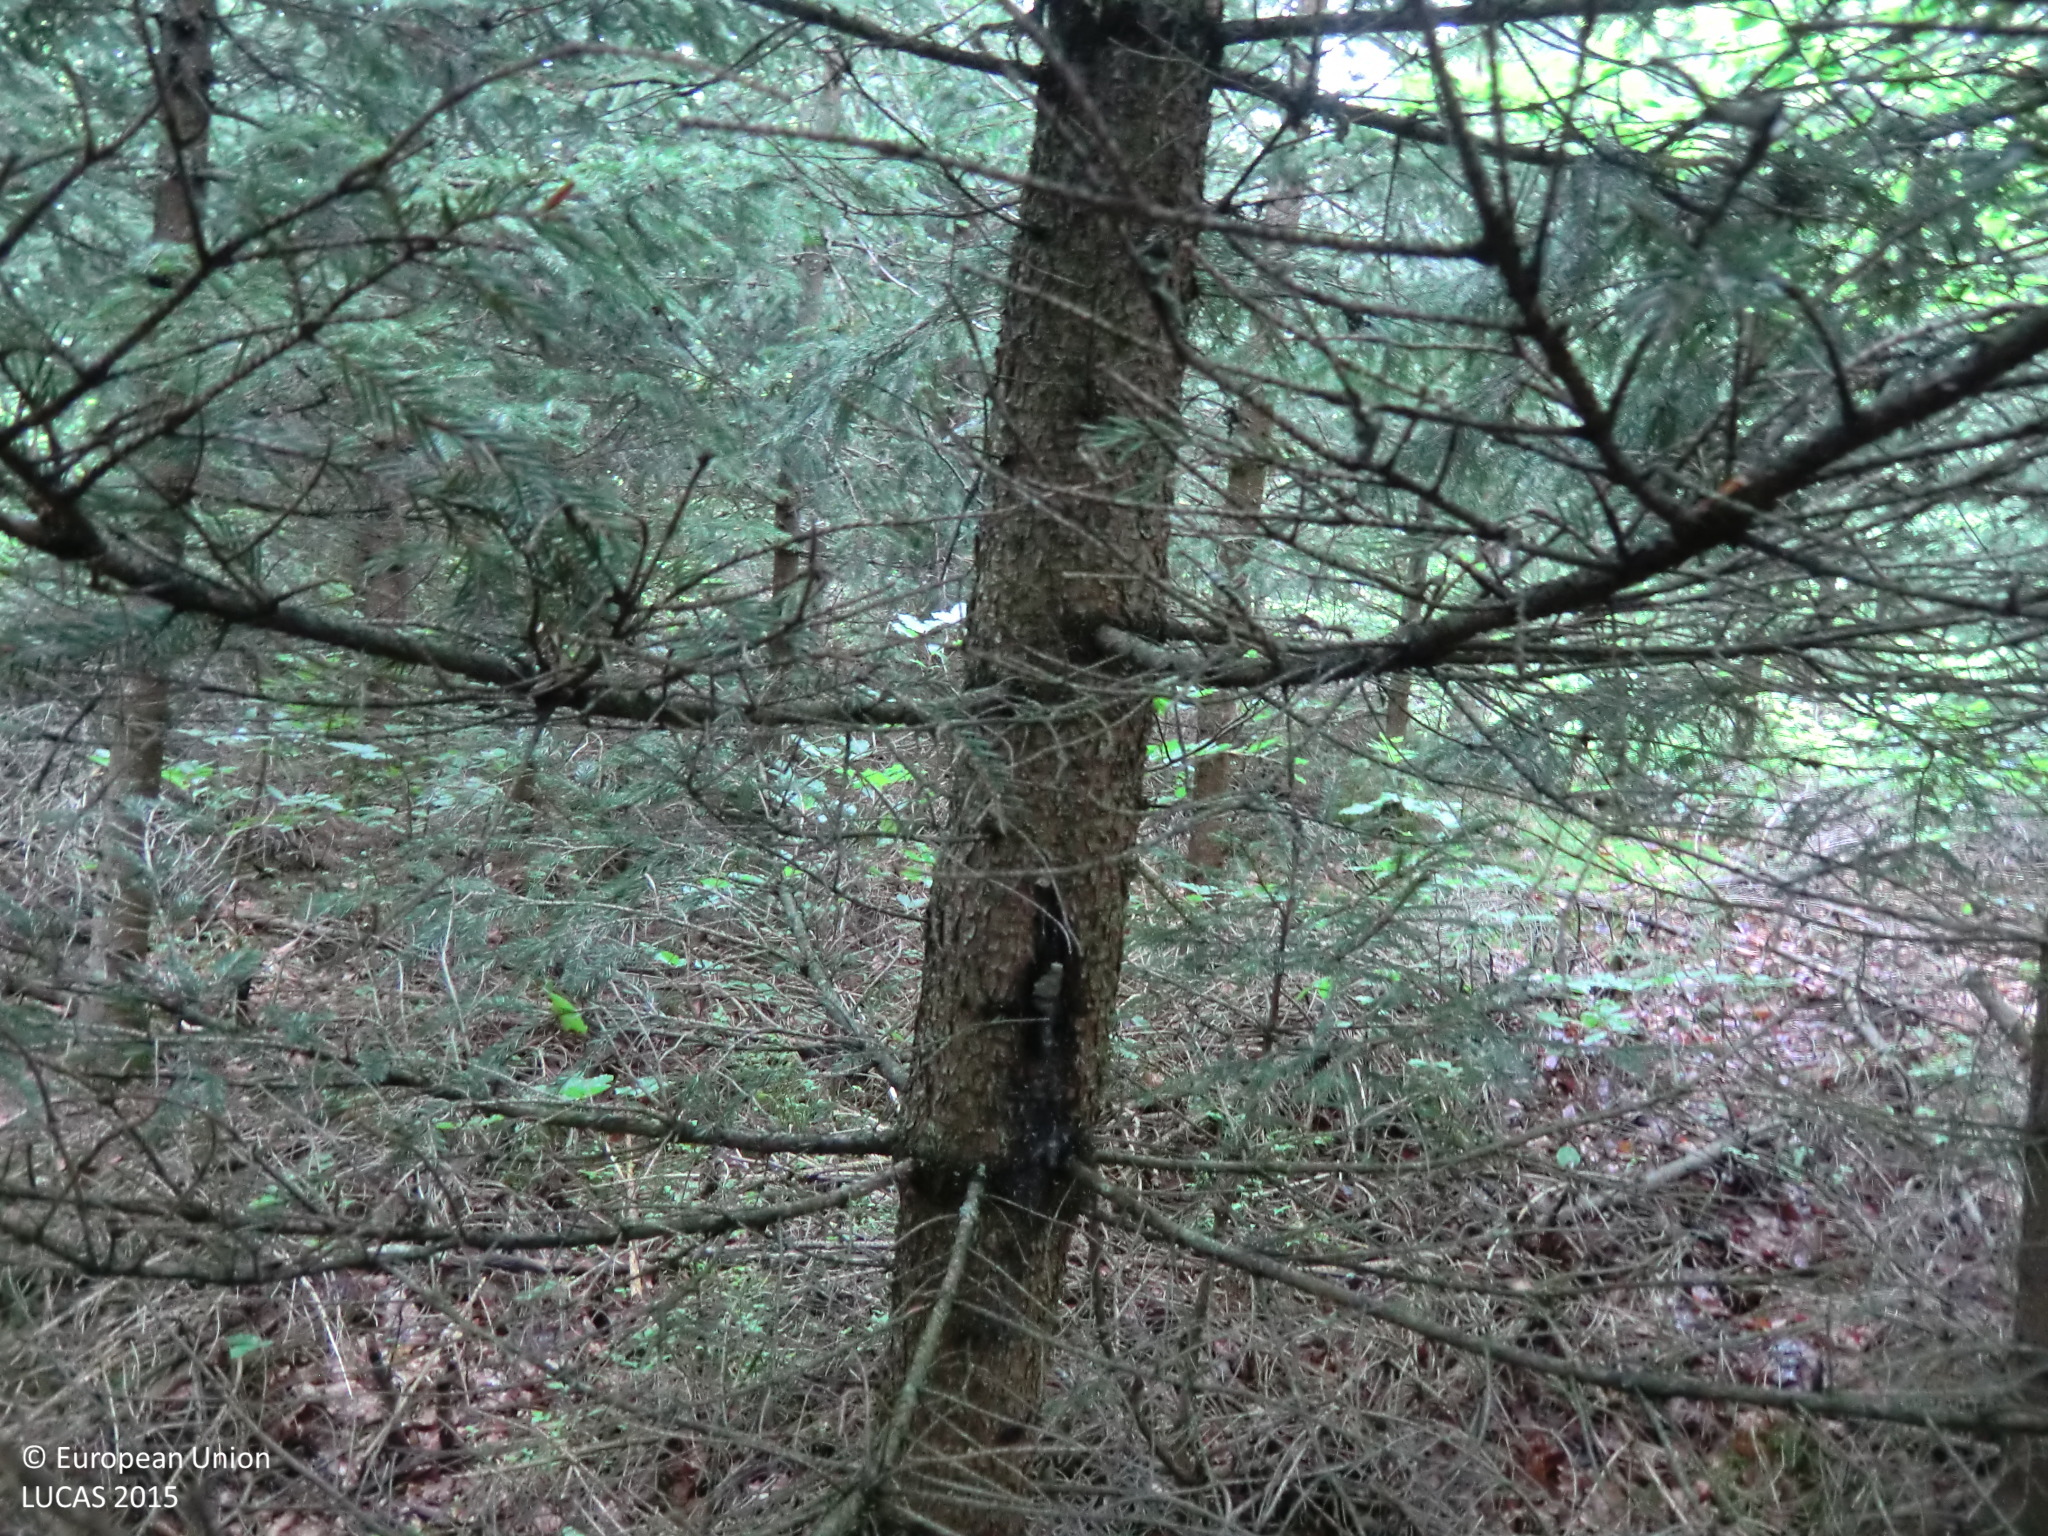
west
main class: Woodland
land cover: Spruce dominated mixed woodland
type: hemiboreal forest and nemoral coniferous forest and mixed broadleaved-coniferous forest
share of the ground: > 75 %
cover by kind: coniferous forest trees 50 %, broadleaved forest trees 30 %, shrubs 20 %
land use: Forestry
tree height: > 5 m
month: May
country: AT
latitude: 48.3992
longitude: 14.9855
